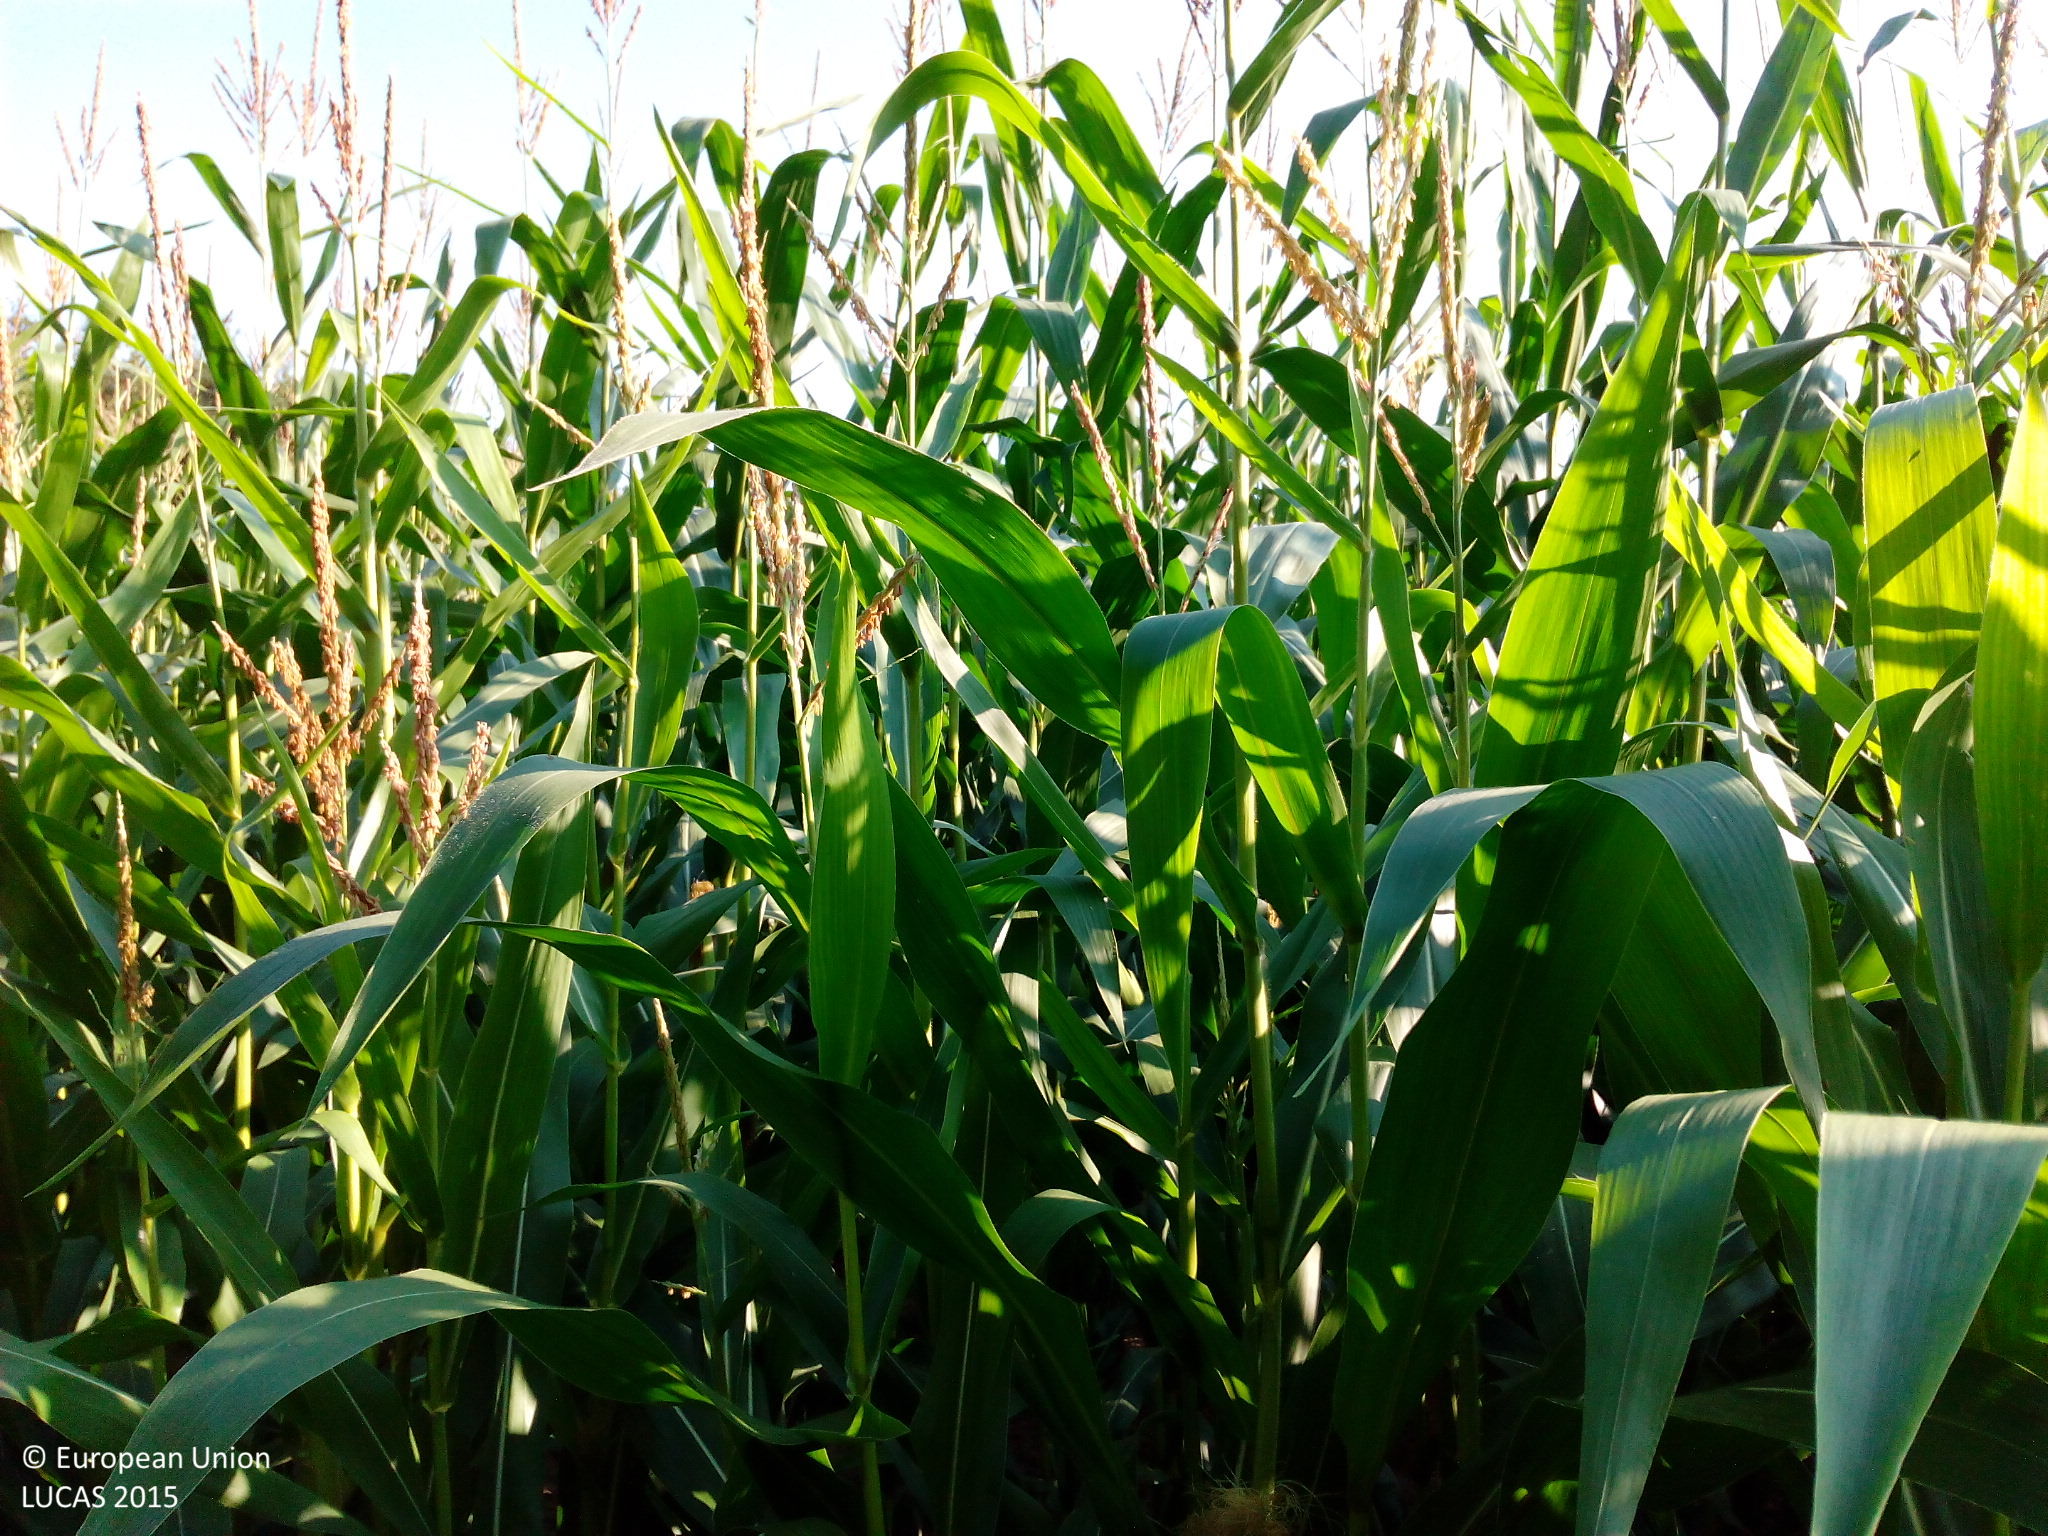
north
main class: Cropland
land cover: Maize
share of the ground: > 75 %
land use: Agriculture (excluding fallow land and kitchen gardens)
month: August
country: DE
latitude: 48.7441
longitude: 10.5301
